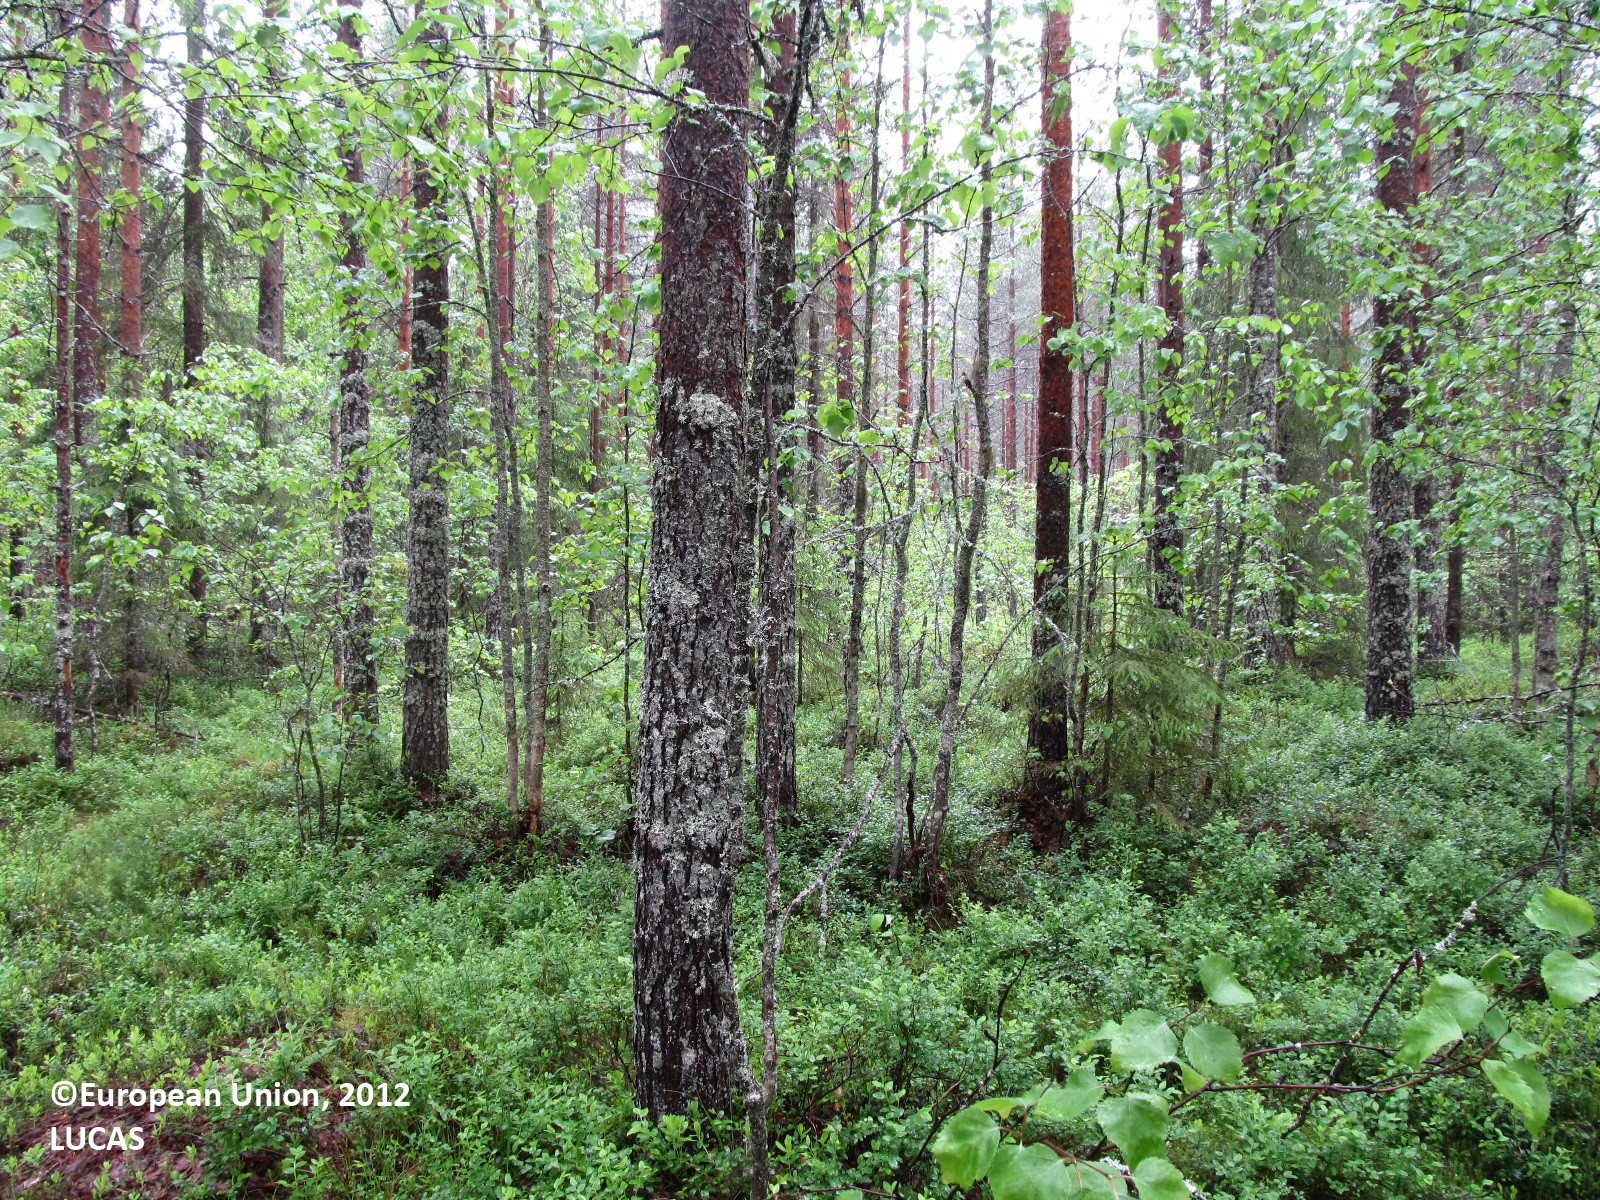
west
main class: Woodland
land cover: Pine dominated mixed woodland
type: boreal forest
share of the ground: 50 - 75 %
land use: Forestry
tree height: > 5 m
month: June
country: FI
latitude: 63.0722
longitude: 29.0783
